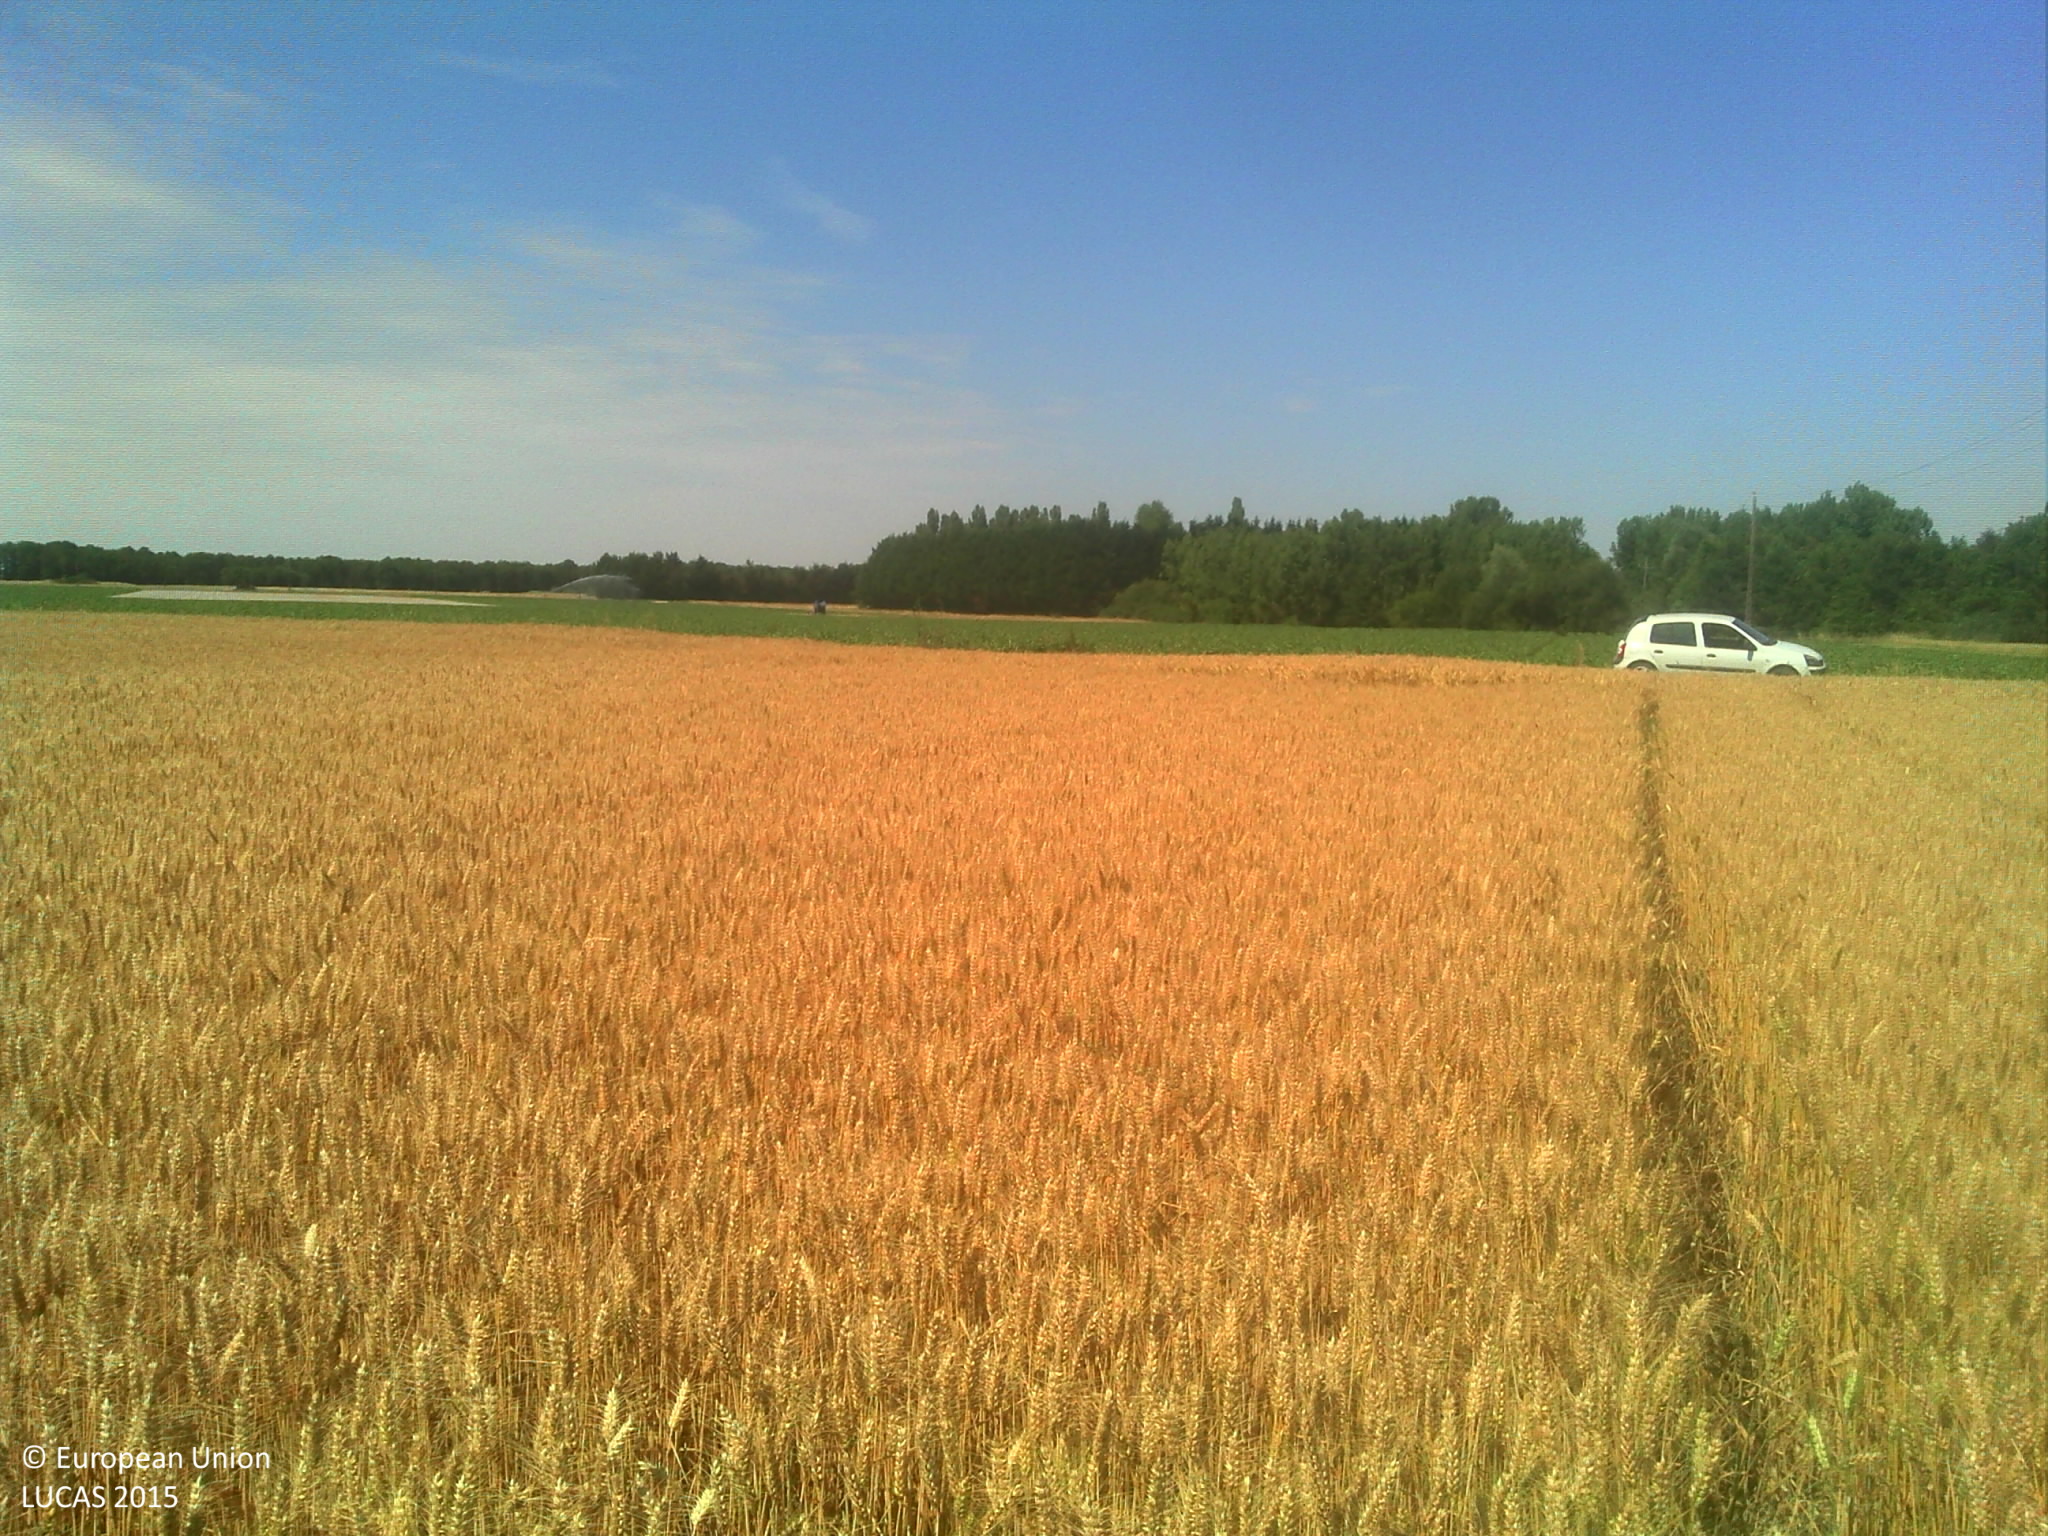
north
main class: Cropland
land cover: Durum wheat
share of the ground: > 75 %
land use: Agriculture (excluding fallow land and kitchen gardens)
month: June
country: FR
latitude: 47.4098
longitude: 1.5448
